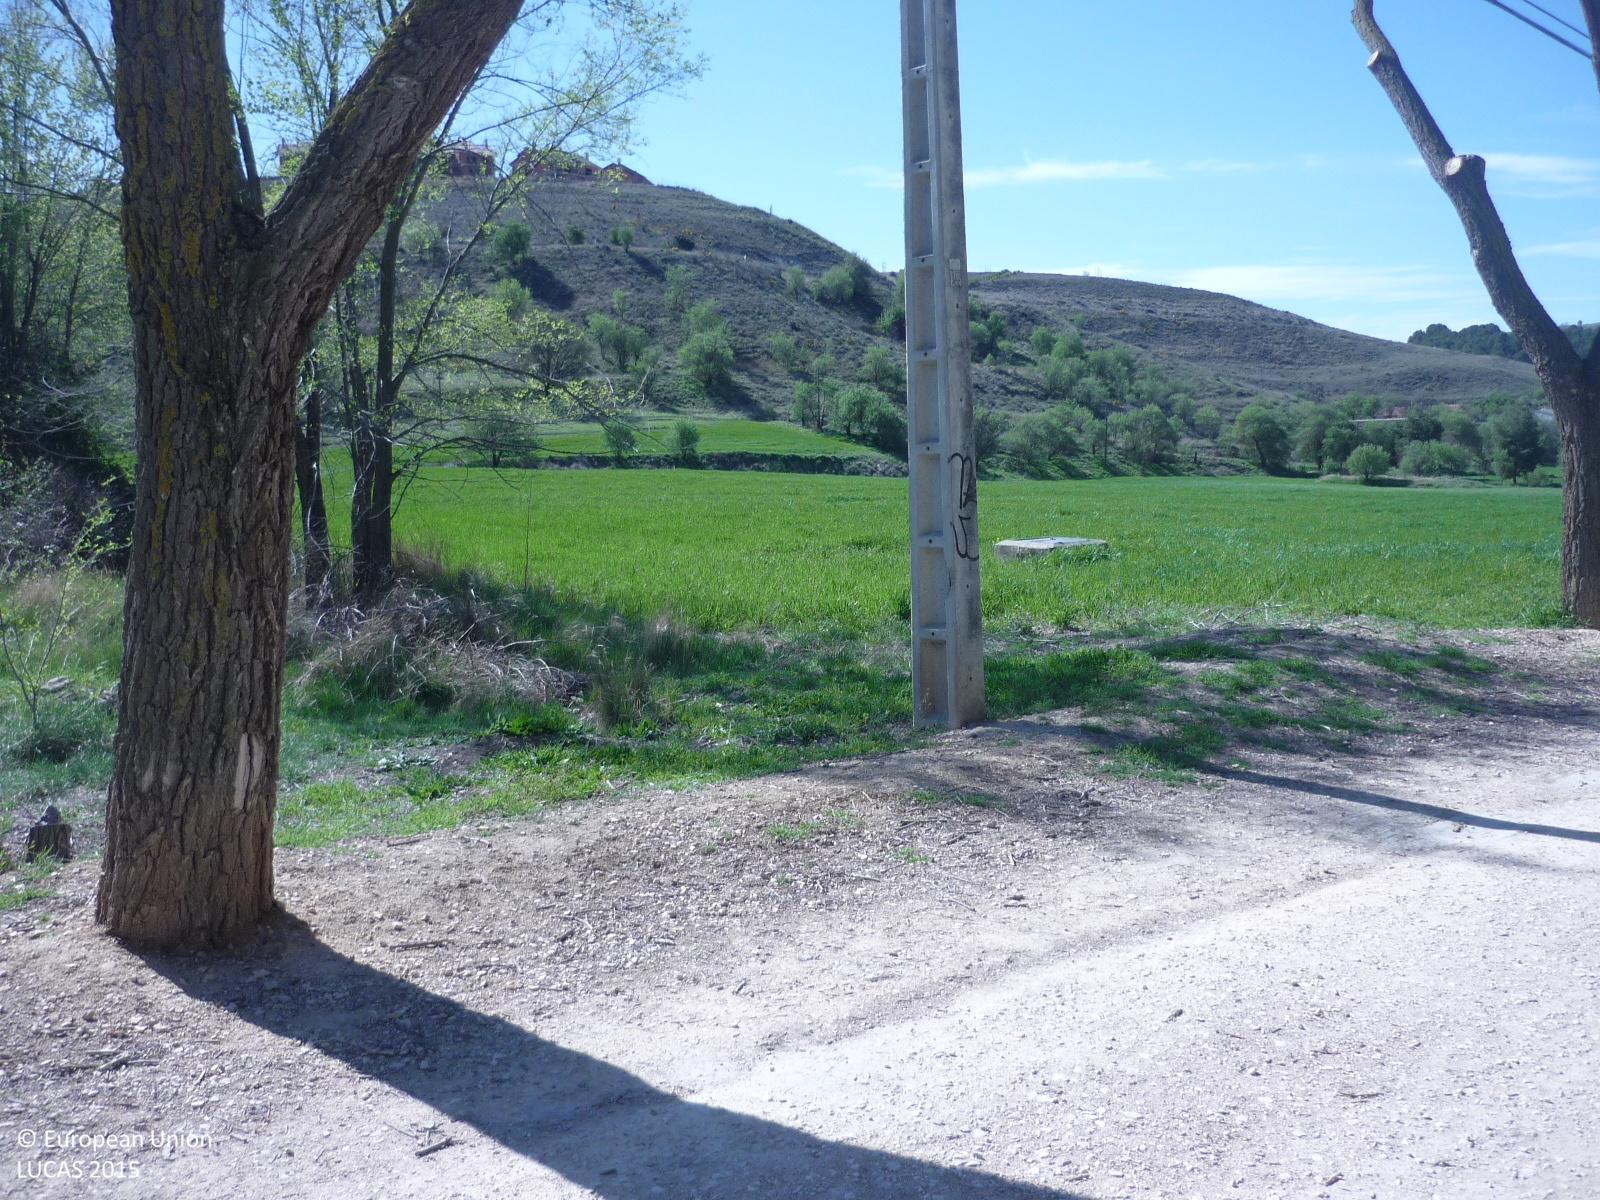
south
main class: Woodland
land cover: Broadleaved woodland
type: thermophilous deciduous forest
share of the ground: 50 - 75 %
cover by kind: broadleaved forest trees 70 %, unconsolidated bare surface 30 %
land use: Amenities, museums, leisure
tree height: < 5 m
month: April
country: ES
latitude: 40.4381
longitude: -3.2951
